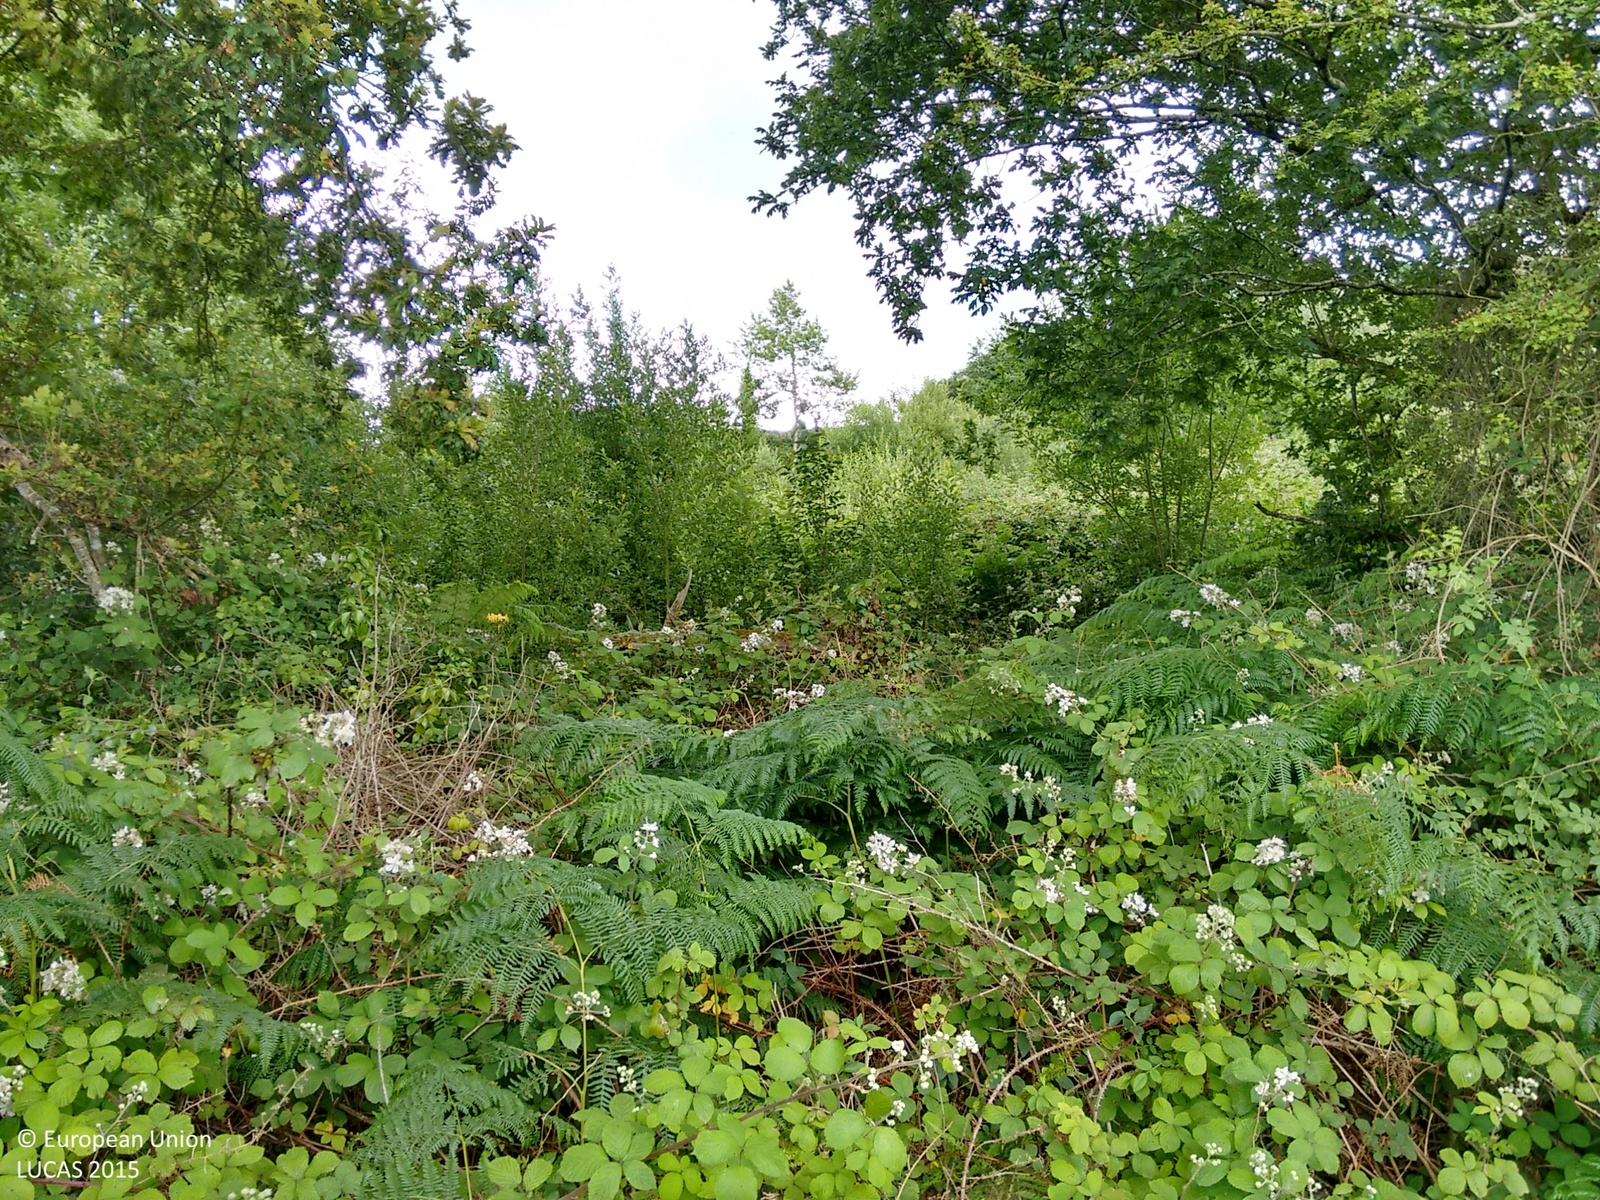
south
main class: Shrubland
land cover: Shrubland with sparse tree cover
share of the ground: > 75 %
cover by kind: shrubs 70 %, herbaceous plants 15 %, lichens and mosses 10 %, broadleaved forest trees 5 %
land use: Semi-natural and natural areas not in use
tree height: > 5 m
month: July
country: IE
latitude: 52.8798
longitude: -8.3925
